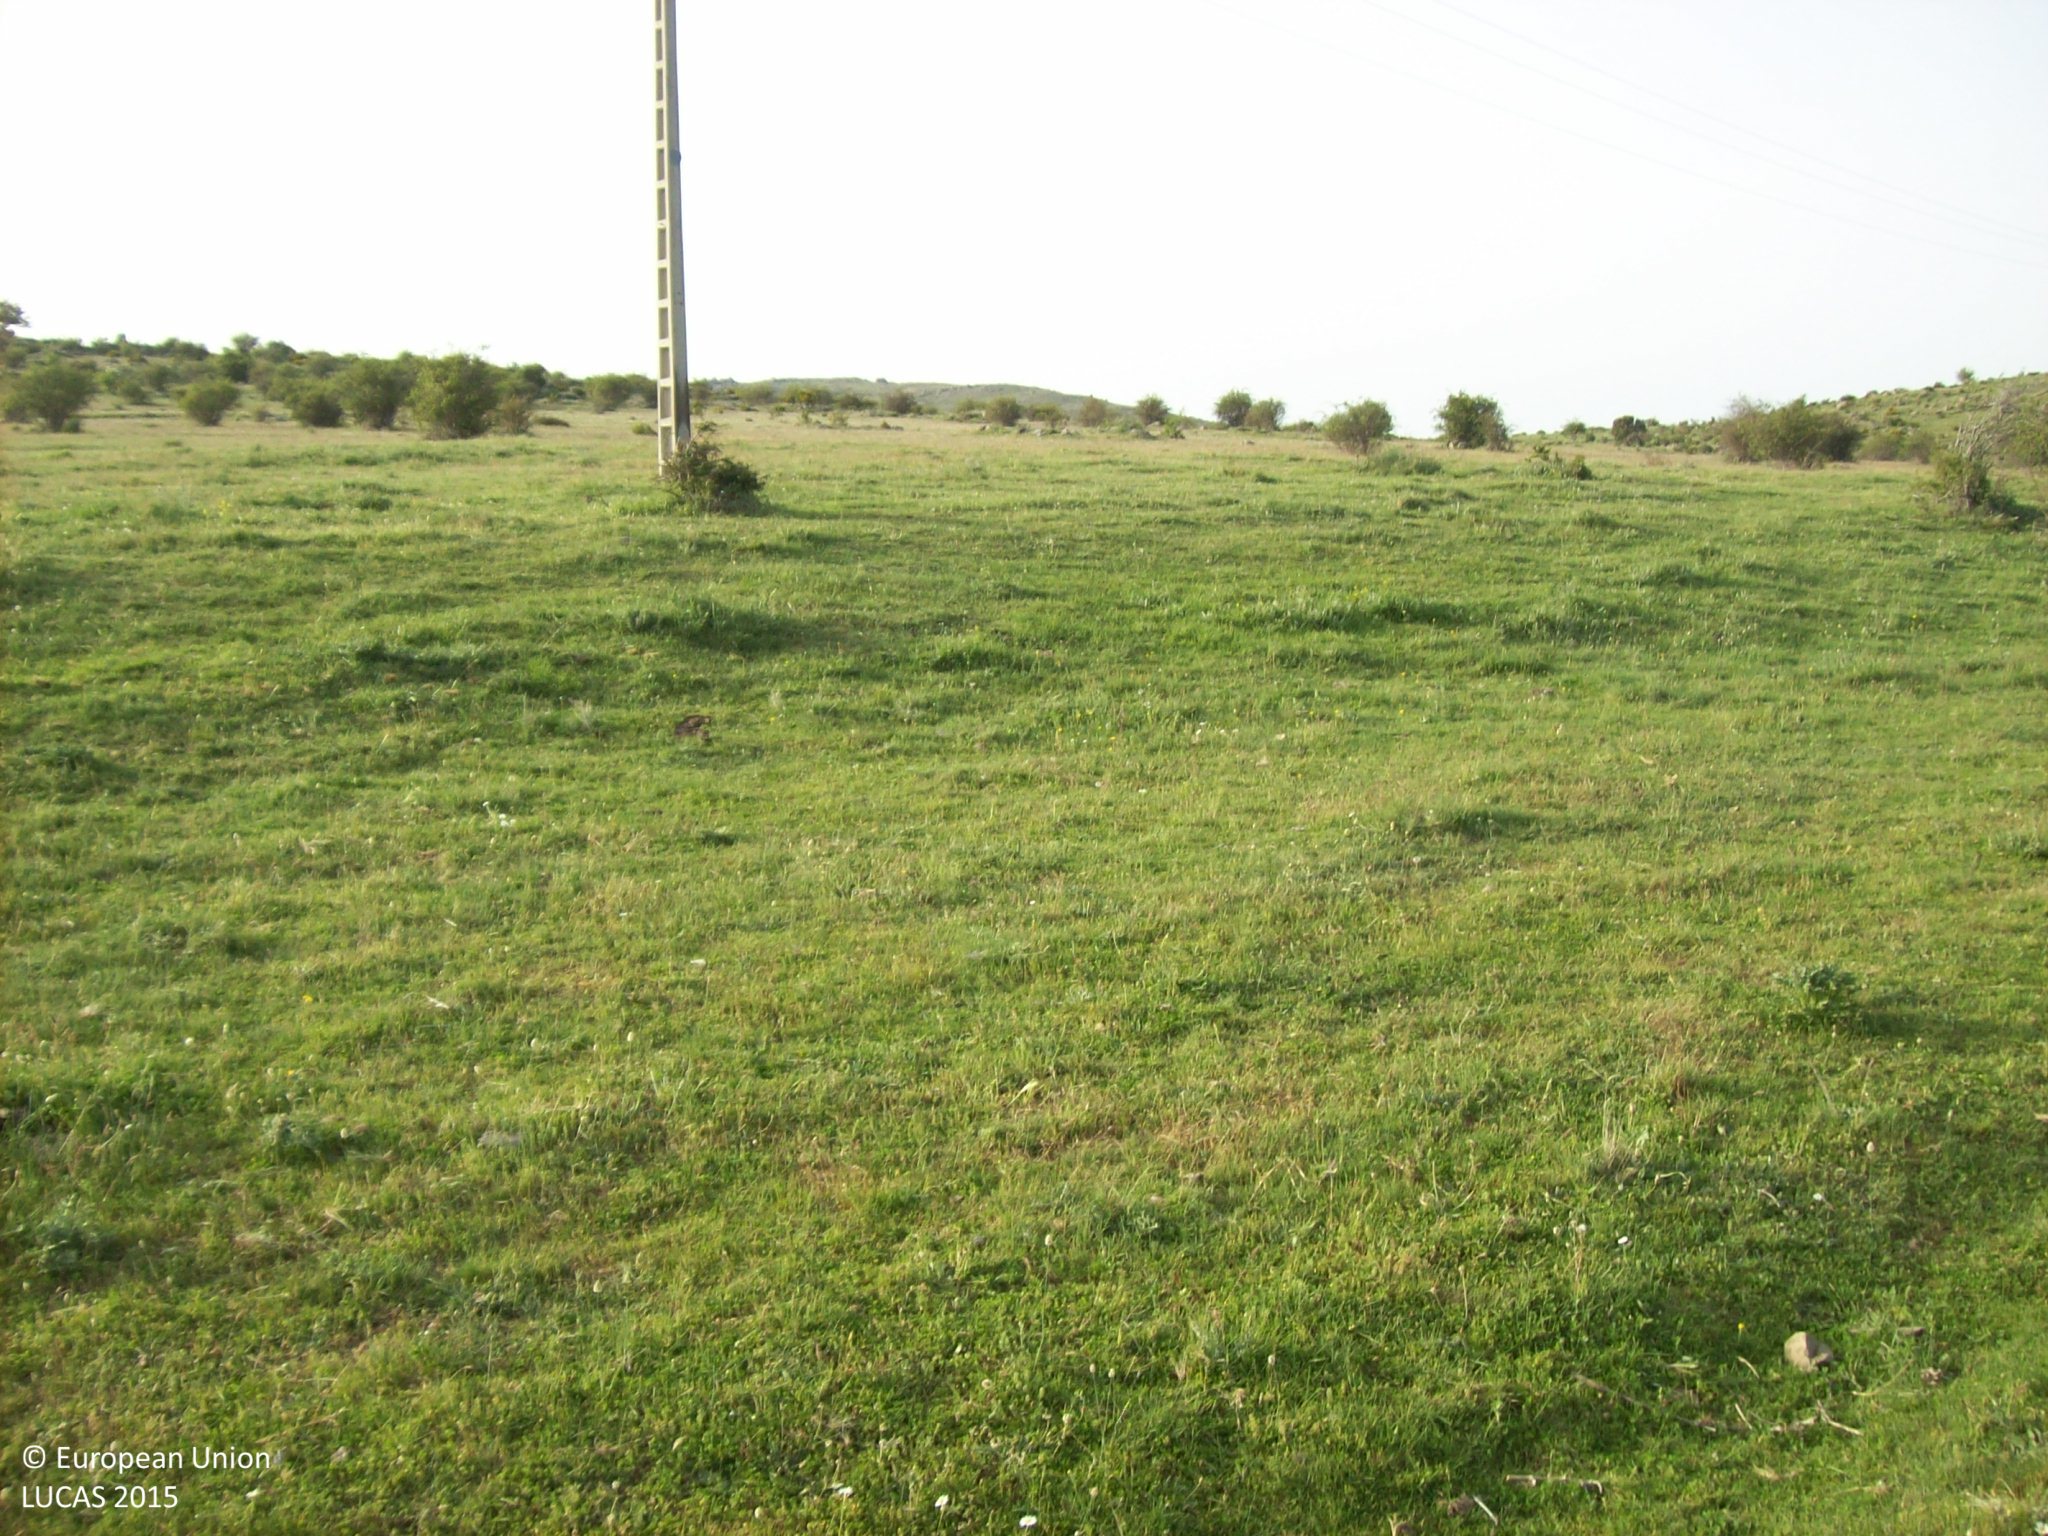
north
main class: Grassland
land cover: Grassland without tree/shrub cover
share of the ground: > 75 %
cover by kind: herbaceous plants 95 %
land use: Agriculture (excluding fallow land and kitchen gardens)
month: May
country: ES
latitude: 40.6850
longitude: -4.8850
